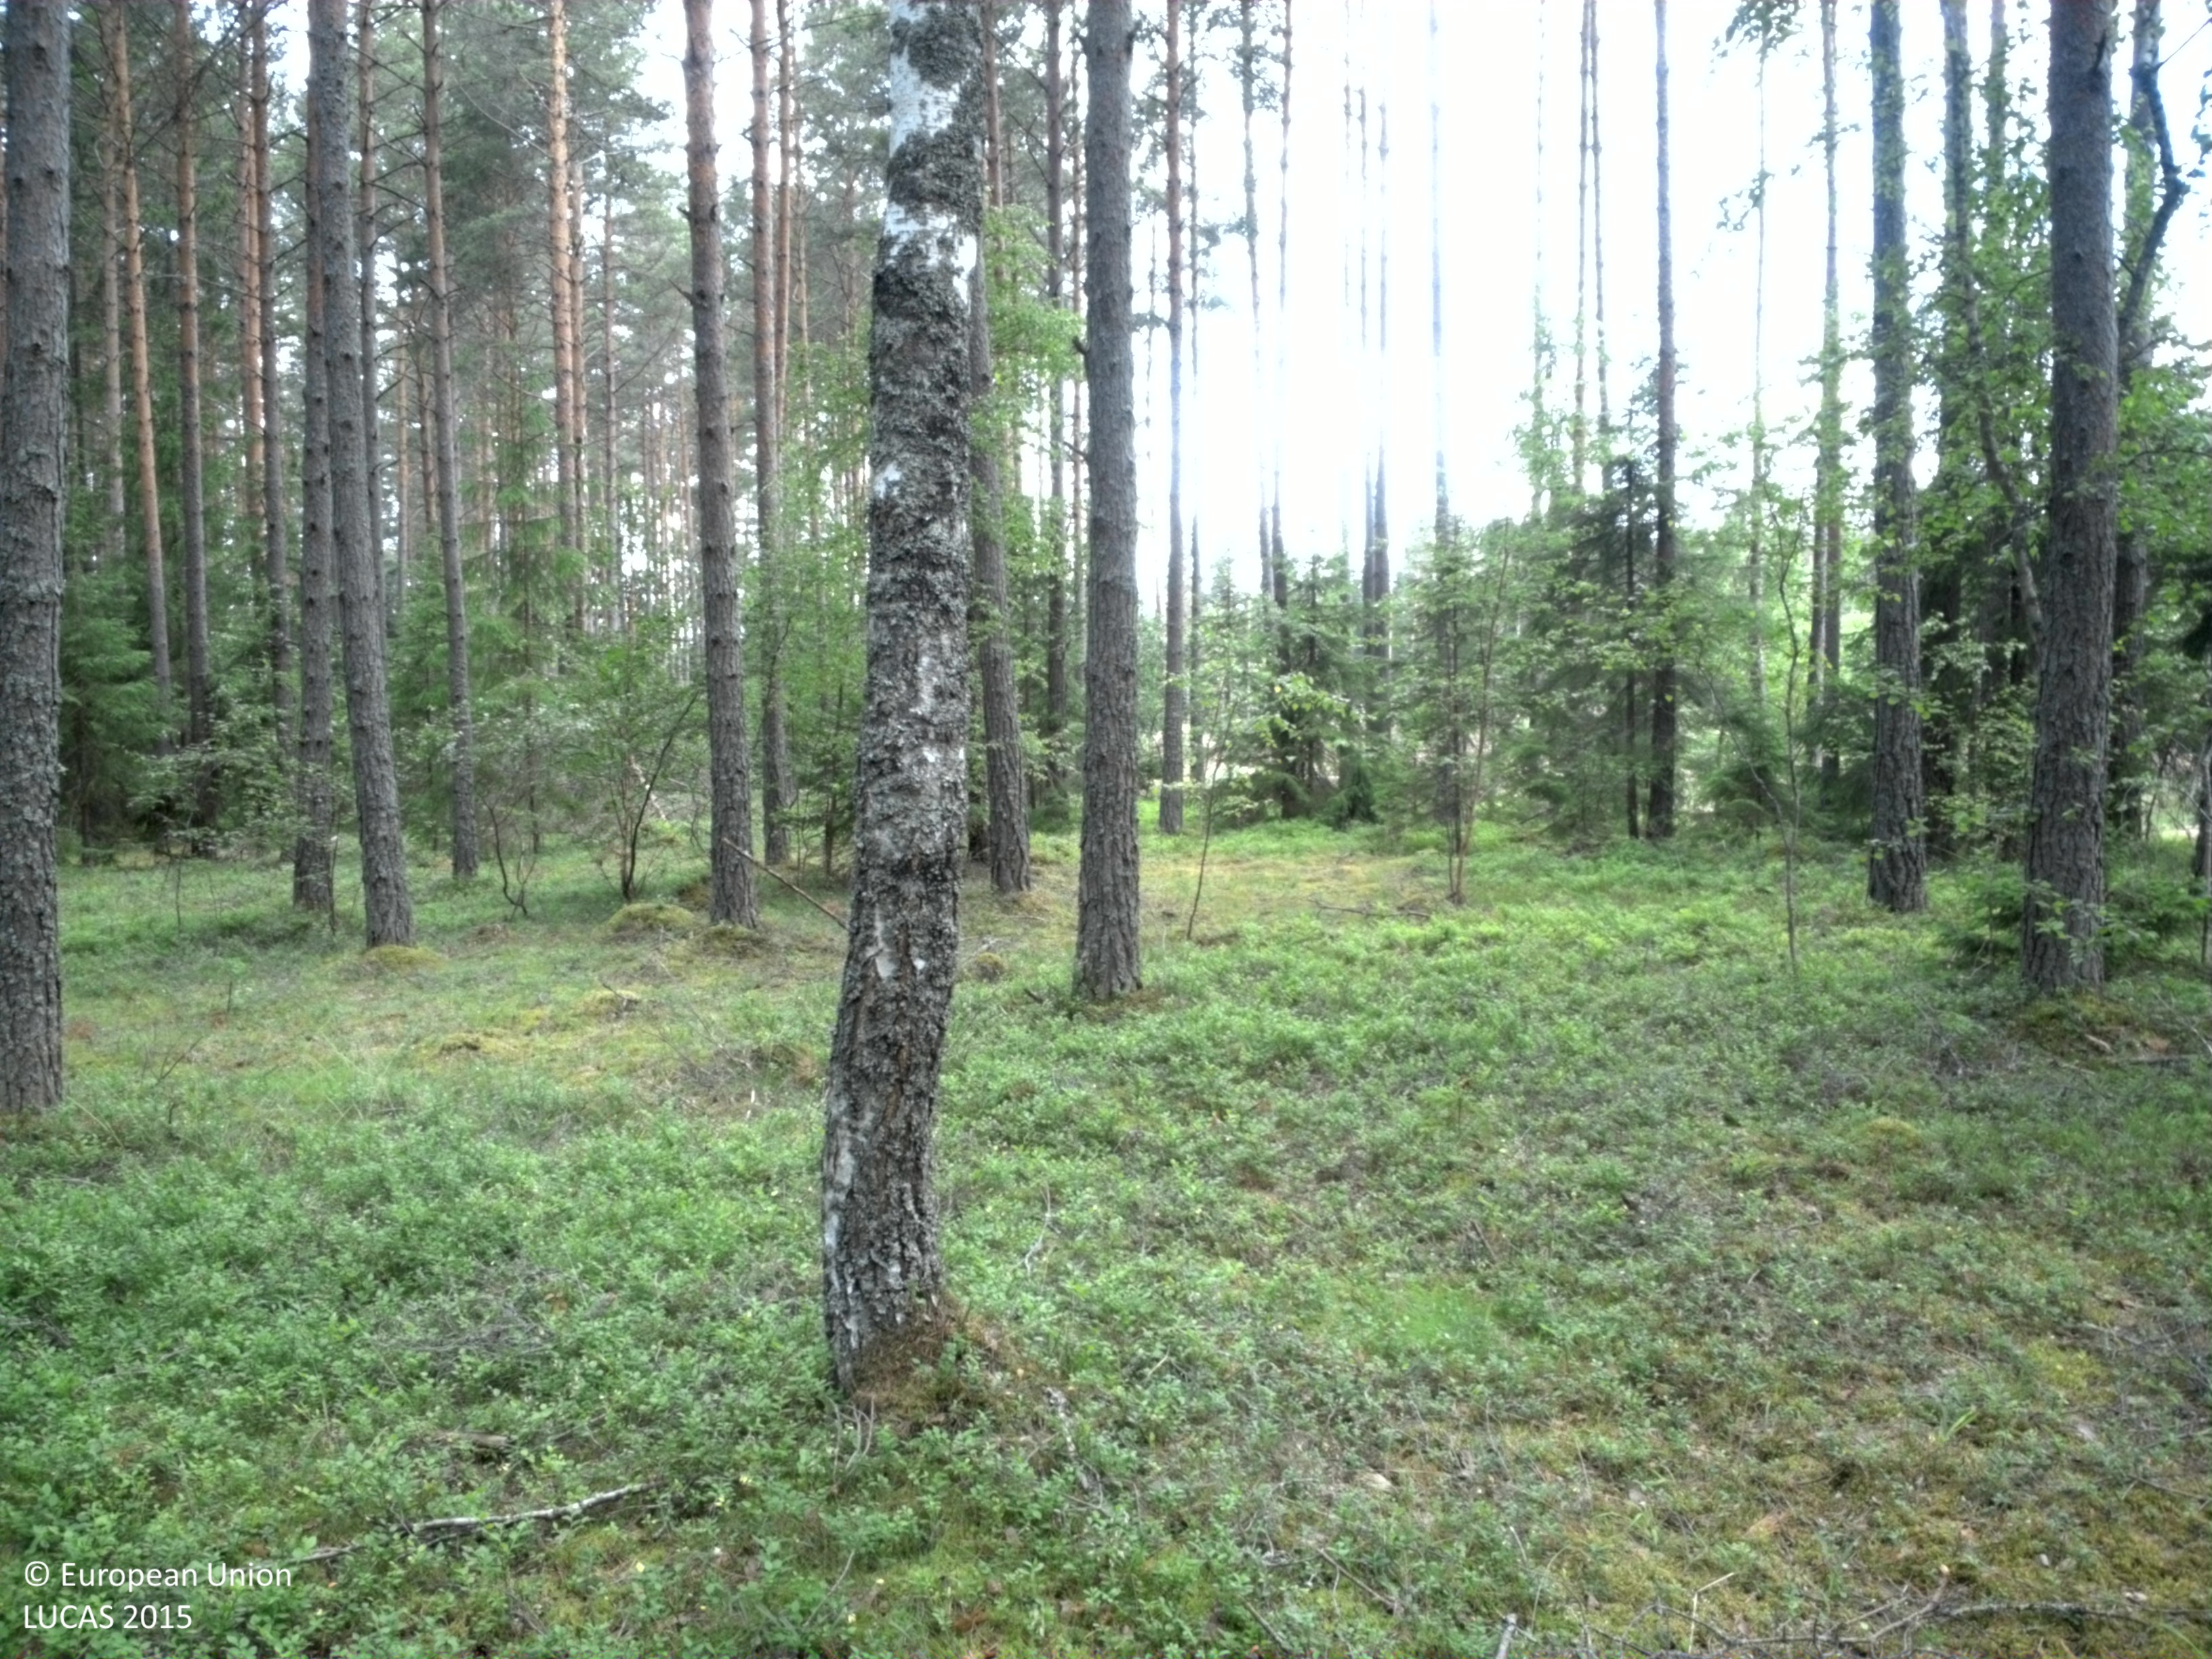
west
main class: Woodland
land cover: Pine dominated mixed woodland
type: boreal forest
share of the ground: > 75 %
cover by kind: coniferous forest trees 60 %, broadleaved forest trees 20 %, herbaceous plants 20 %
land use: Forestry
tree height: > 5 m
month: July
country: SE
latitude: 59.6165
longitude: 18.4900
